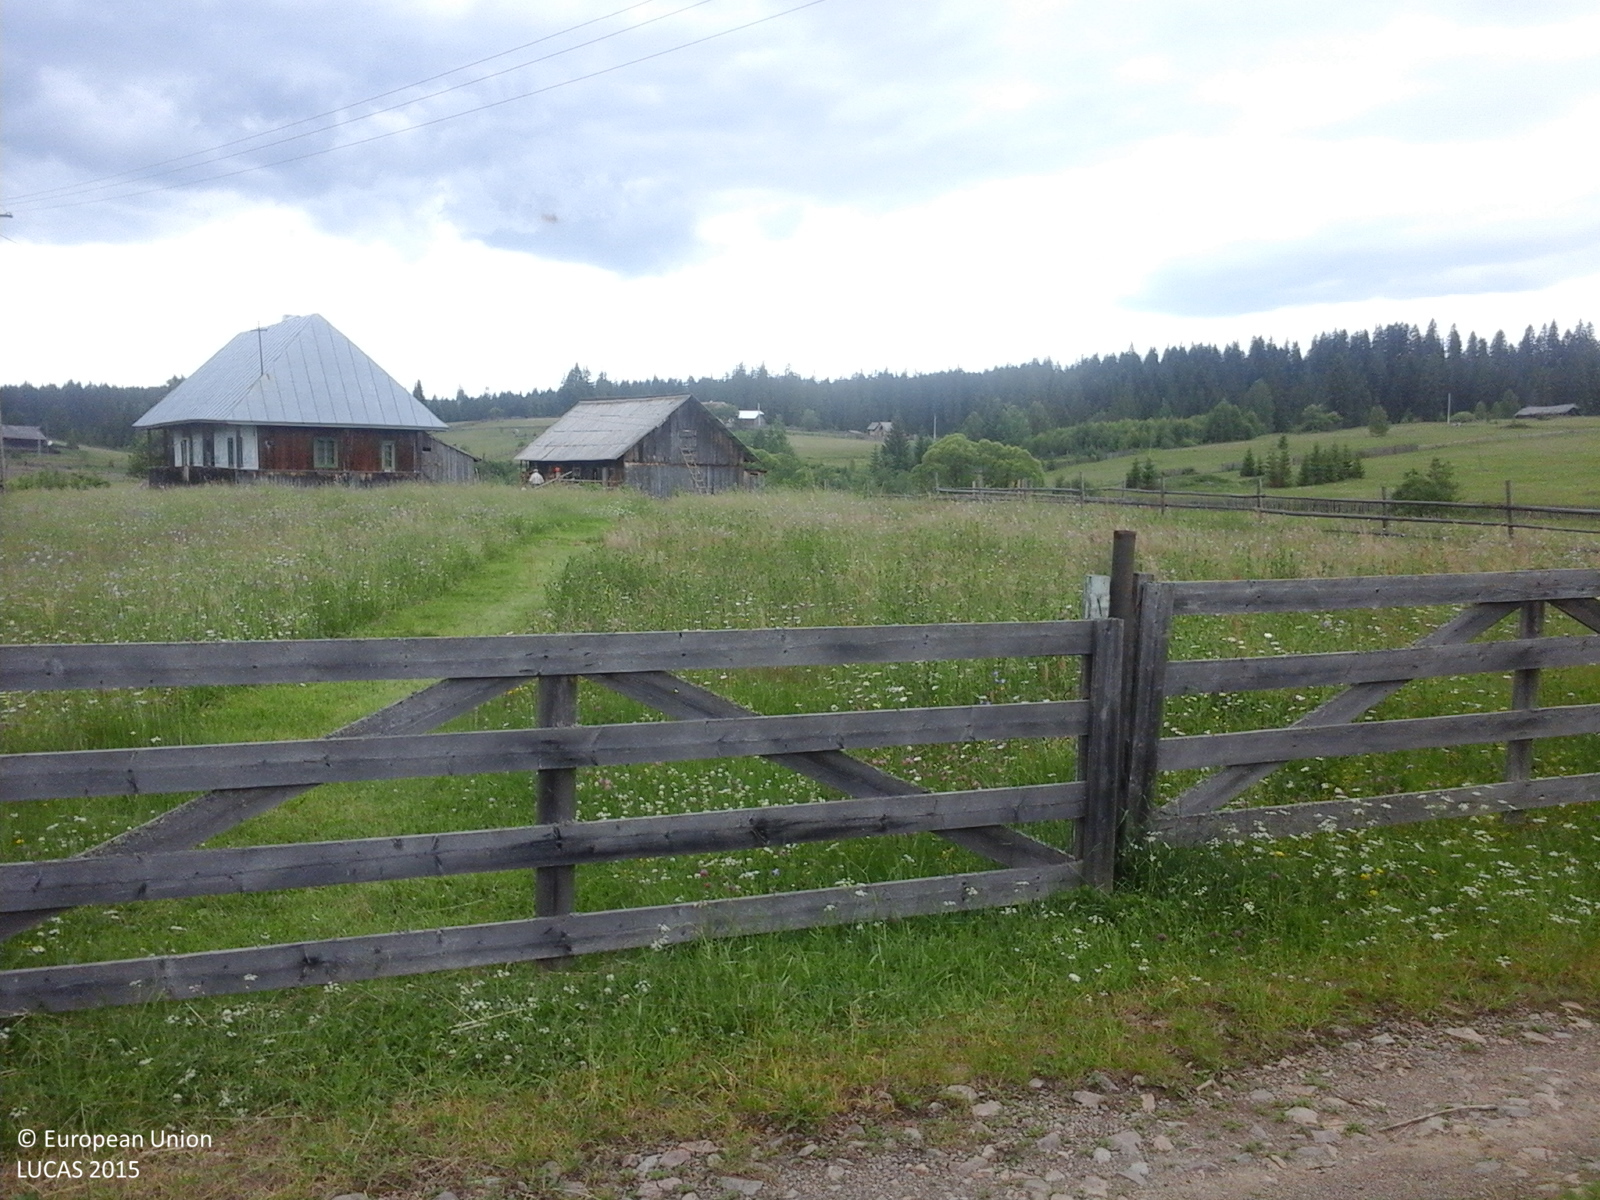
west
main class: Grassland
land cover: Grassland without tree/shrub cover
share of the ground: > 75 %
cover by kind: herbaceous plants 100 %
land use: Agriculture (excluding fallow land and kitchen gardens)
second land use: Residential
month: June
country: RO
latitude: 47.3366
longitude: 25.1271
